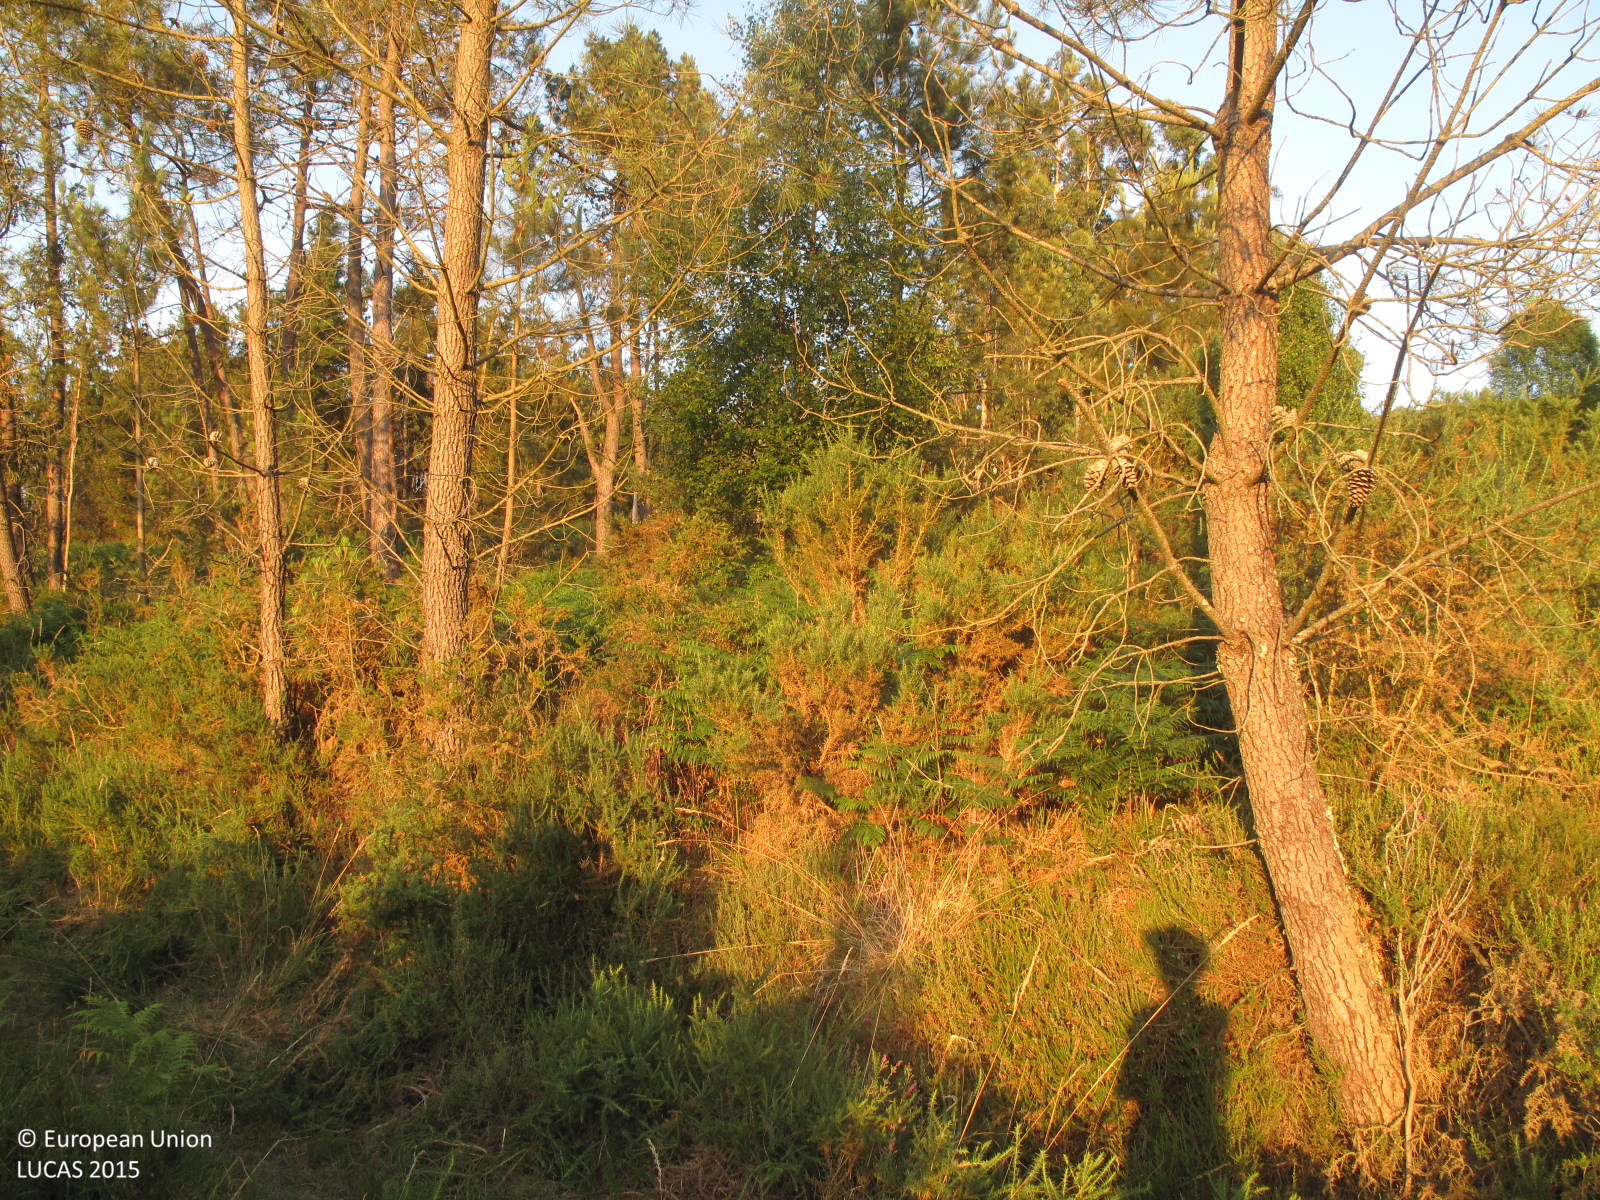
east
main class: Shrubland
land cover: Shrubland with sparse tree cover
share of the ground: > 75 %
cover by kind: shrubs 75 %, herbaceous plants 20 %, coniferous forest trees 5 %
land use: Semi-natural and natural areas not in use
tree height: > 5 m
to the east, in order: Shrubland with sparse tree cover; Tracks; Pine dominated coniferous woodland; Broadleaved woodland; Shrubland without tree cover
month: July
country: ES
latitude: 43.2949
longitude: -8.0031
